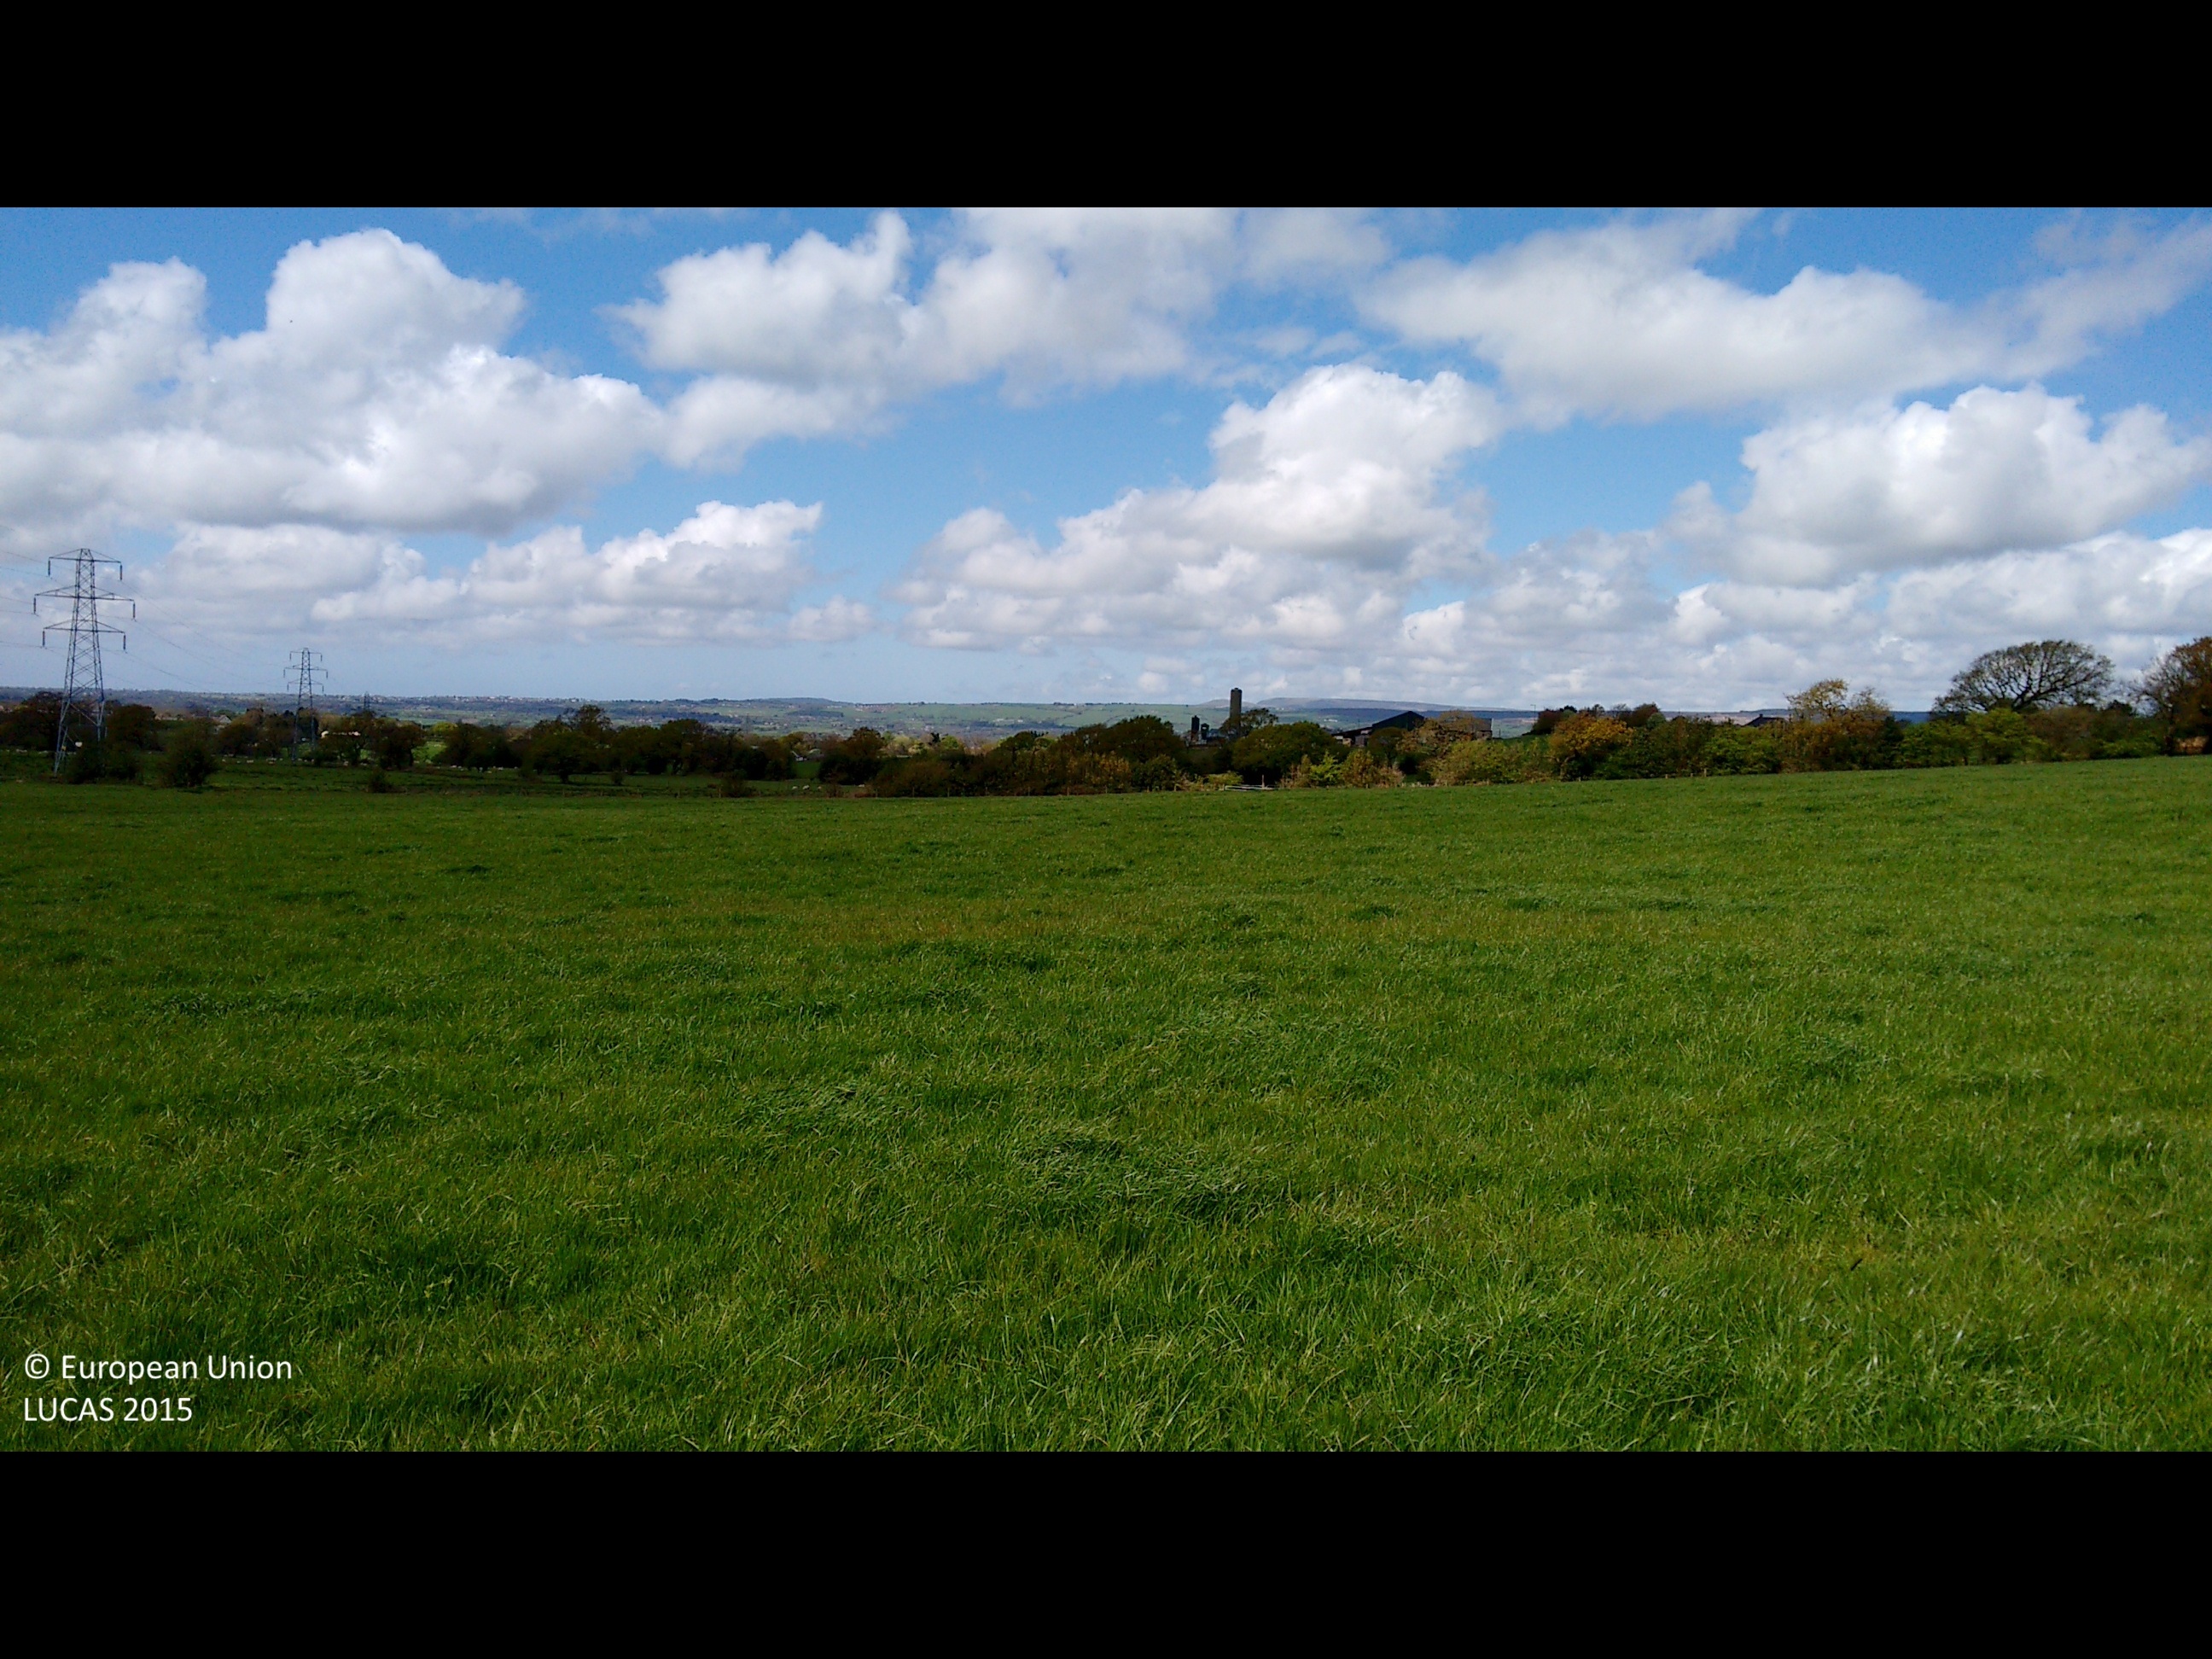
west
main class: Grassland
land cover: Grassland without tree/shrub cover
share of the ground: > 75 %
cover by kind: herbaceous plants 100 %
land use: Agriculture (excluding fallow land and kitchen gardens)
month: May
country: GB
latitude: 53.7891
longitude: -2.4966
